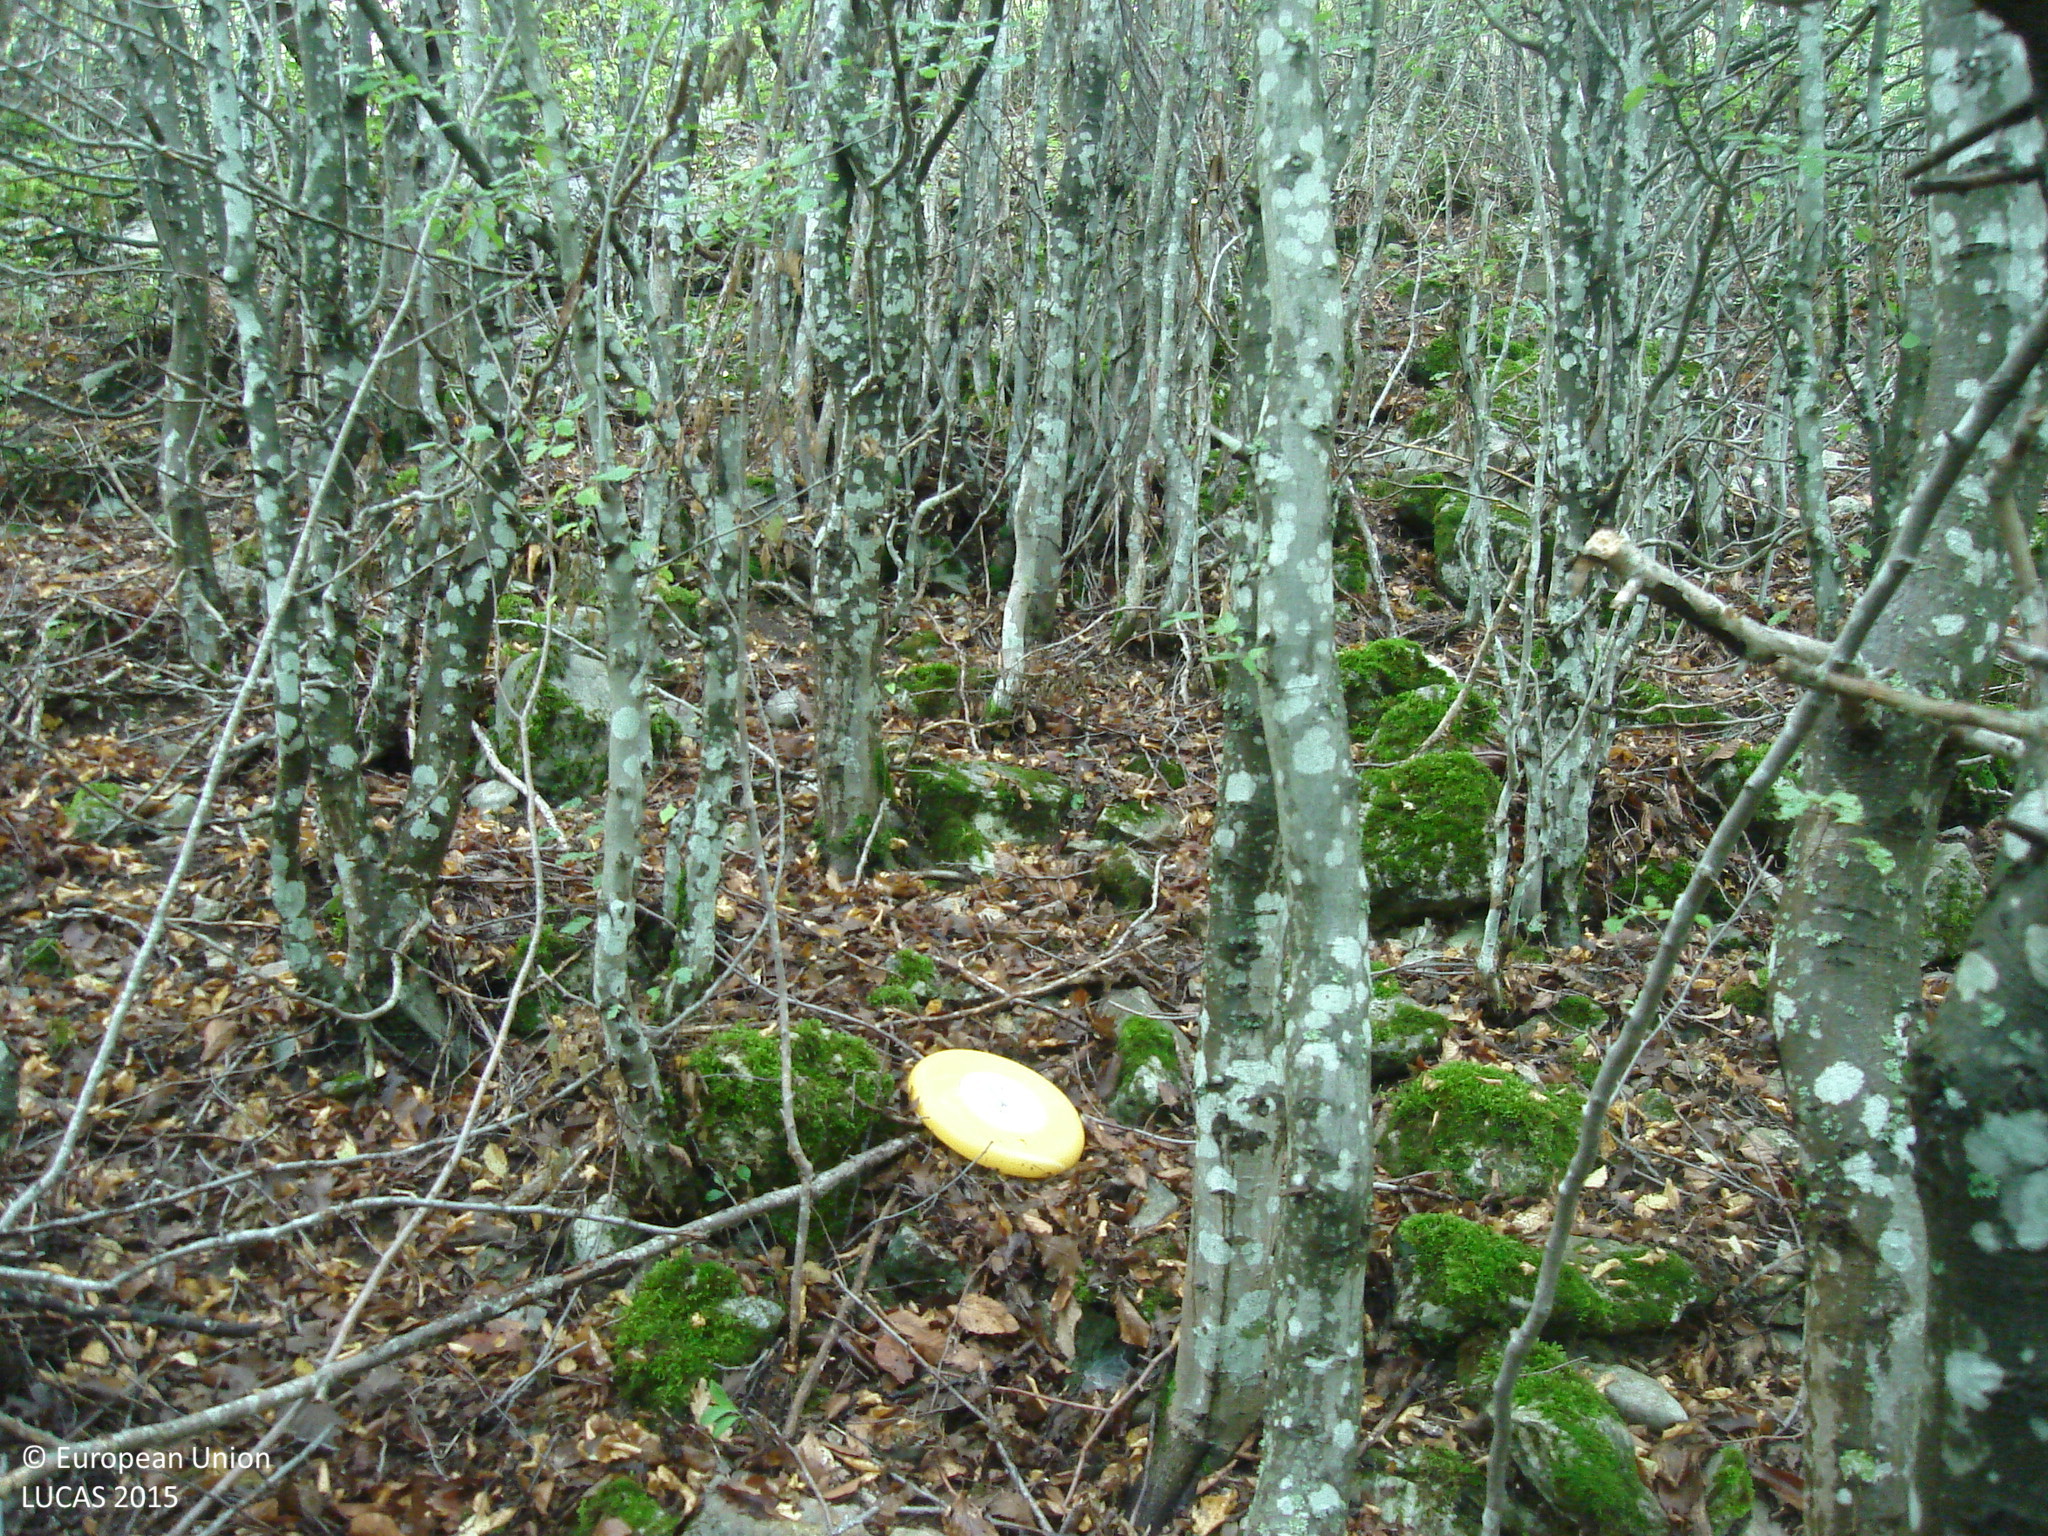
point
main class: Woodland
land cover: Broadleaved woodland
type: mesophytic deciduous forest
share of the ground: > 75 %
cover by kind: broadleaved forest trees 80 %, consolidated bare surface 20 %
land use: Forestry
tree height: > 5 m
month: September
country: BG
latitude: 43.0278
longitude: 23.2039
